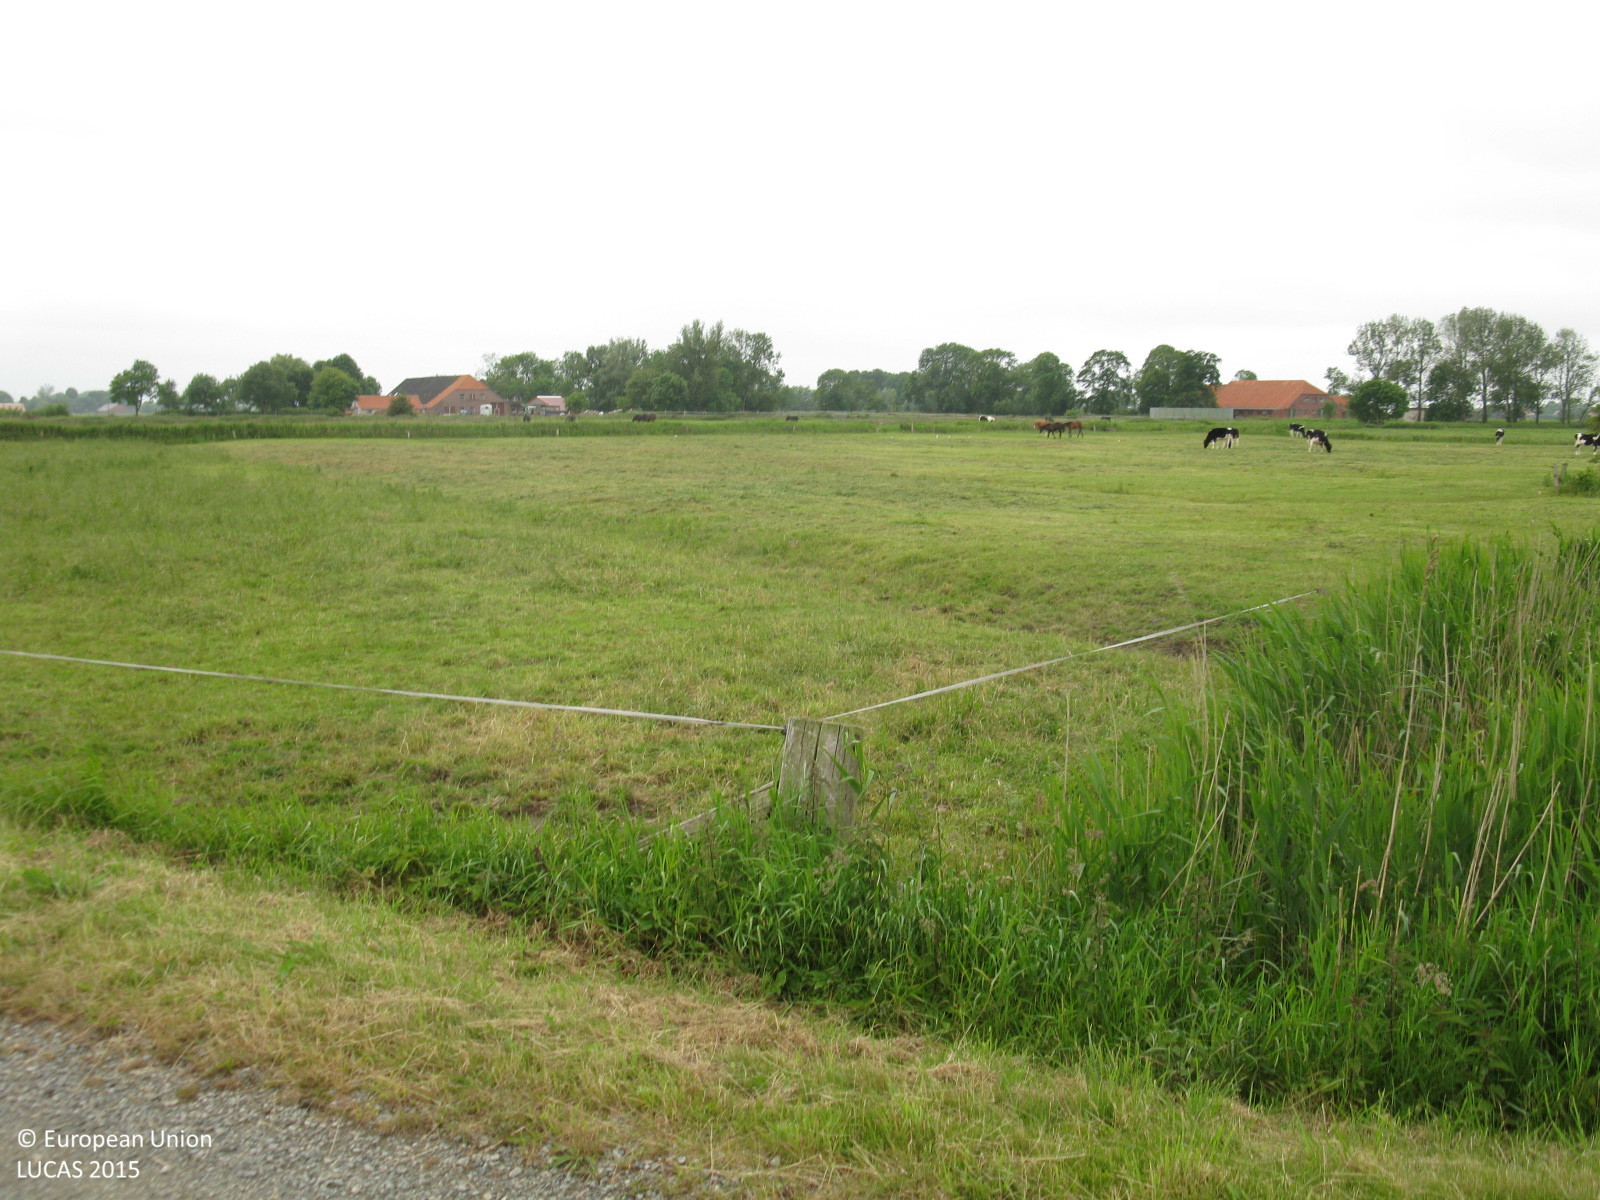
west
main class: Grassland
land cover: Grassland without tree/shrub cover
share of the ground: > 75 %
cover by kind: herbaceous plants 100 %
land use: Agriculture (excluding fallow land and kitchen gardens)
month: June
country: DE
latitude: 53.6534
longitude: 7.8977
